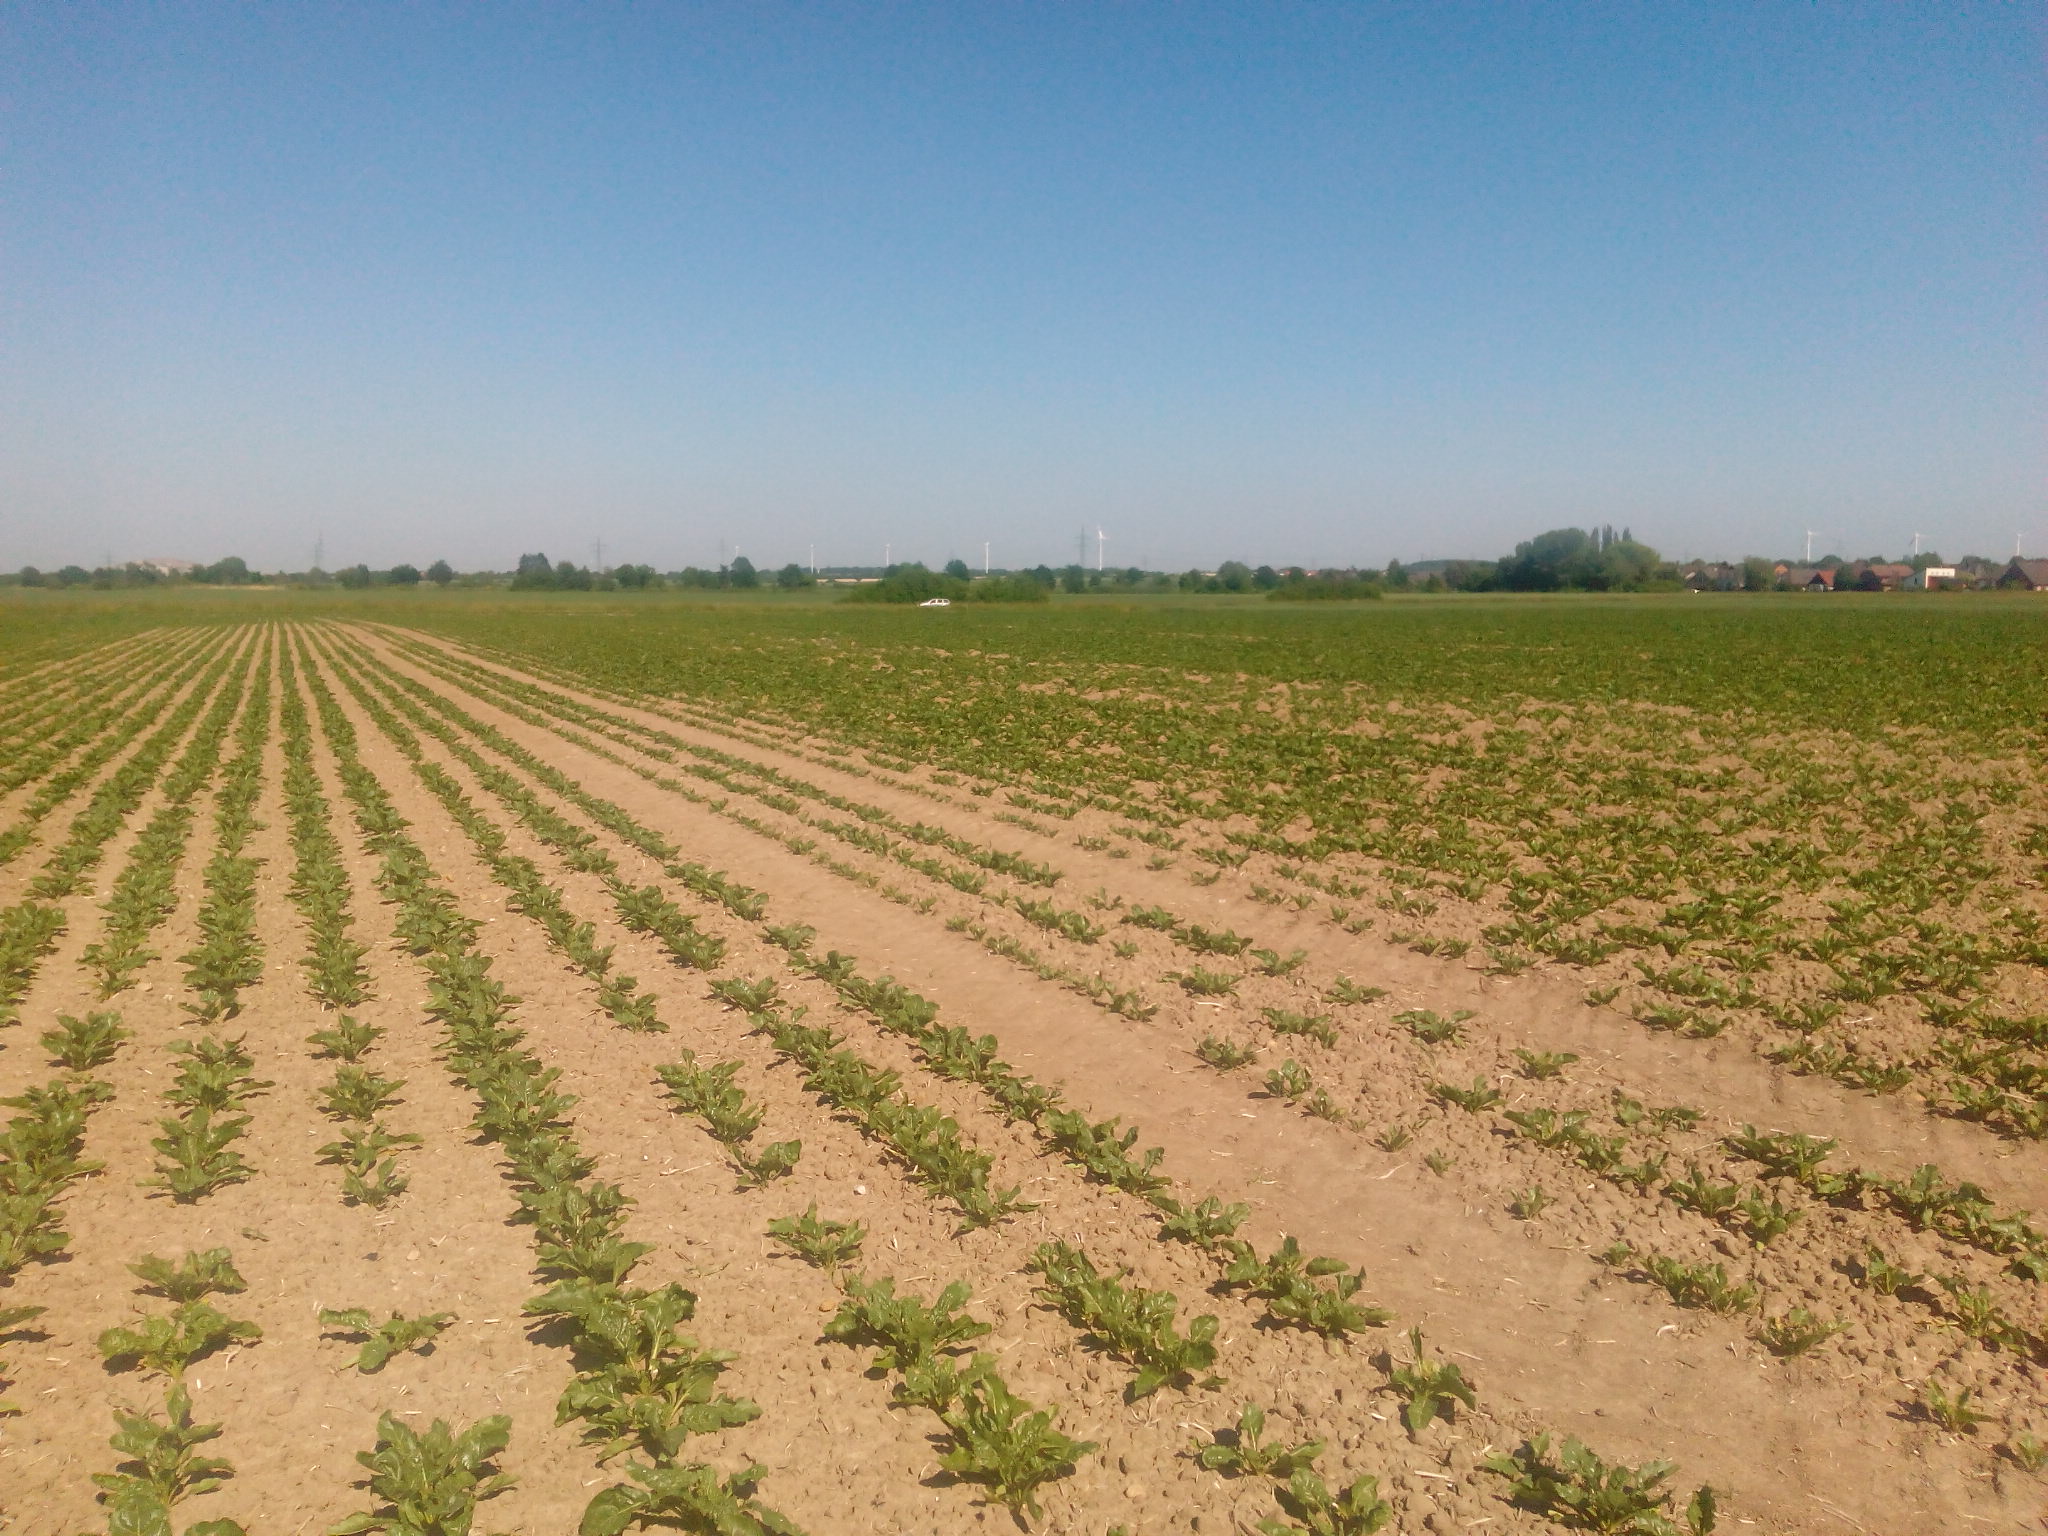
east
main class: Cropland
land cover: Sugar beet
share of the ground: 25 - 50 %
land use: Agriculture (excluding fallow land and kitchen gardens)
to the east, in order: Sugar beet; Grass margins; Ditches and canals; Grass margins; Paved roads, cycling and walking lanes; Grass margins; Ditches and canals; Shrubland with sparse tree cover; Common wheat
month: June
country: DE
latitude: 52.2875
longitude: 9.8681
